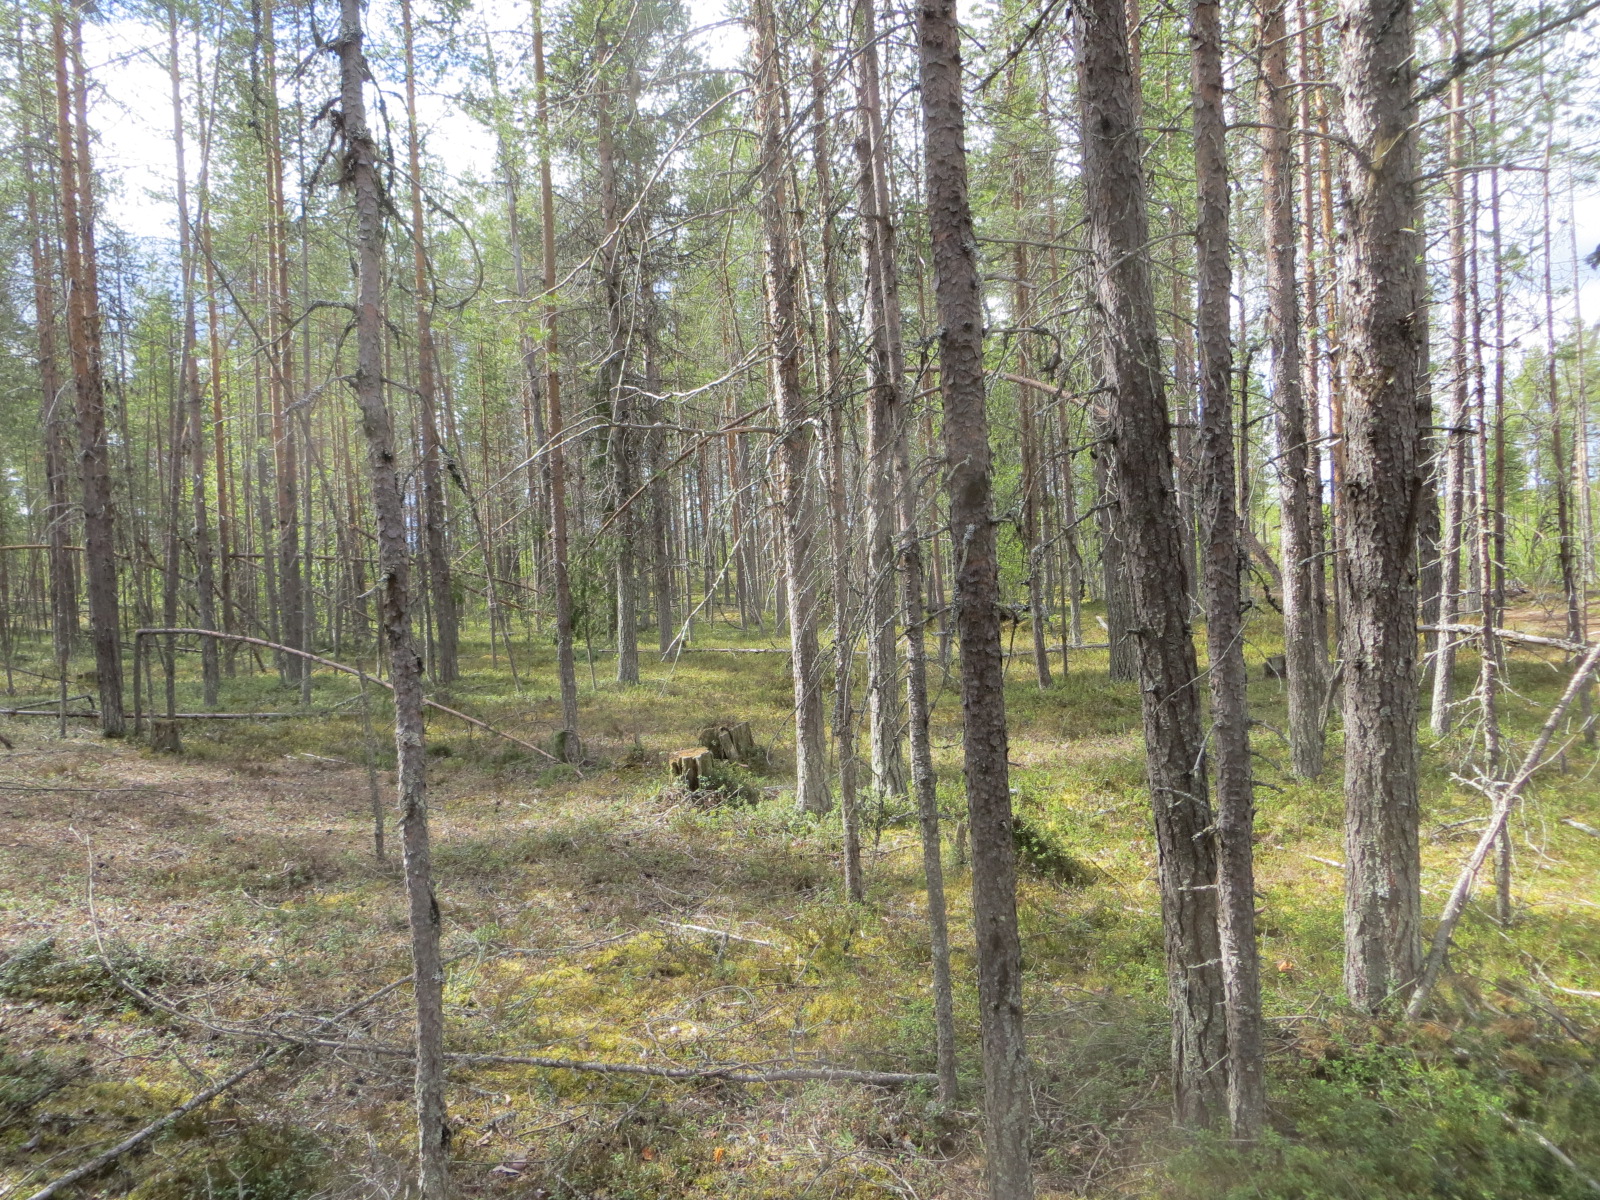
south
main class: Woodland
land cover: Pine dominated coniferous woodland
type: boreal forest
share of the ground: > 75 %
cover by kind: coniferous forest trees 90 %, shrubs 10 %
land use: Forestry
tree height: > 5 m
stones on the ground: < 10 %
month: June
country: FI
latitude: 67.5407
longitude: 25.8898
